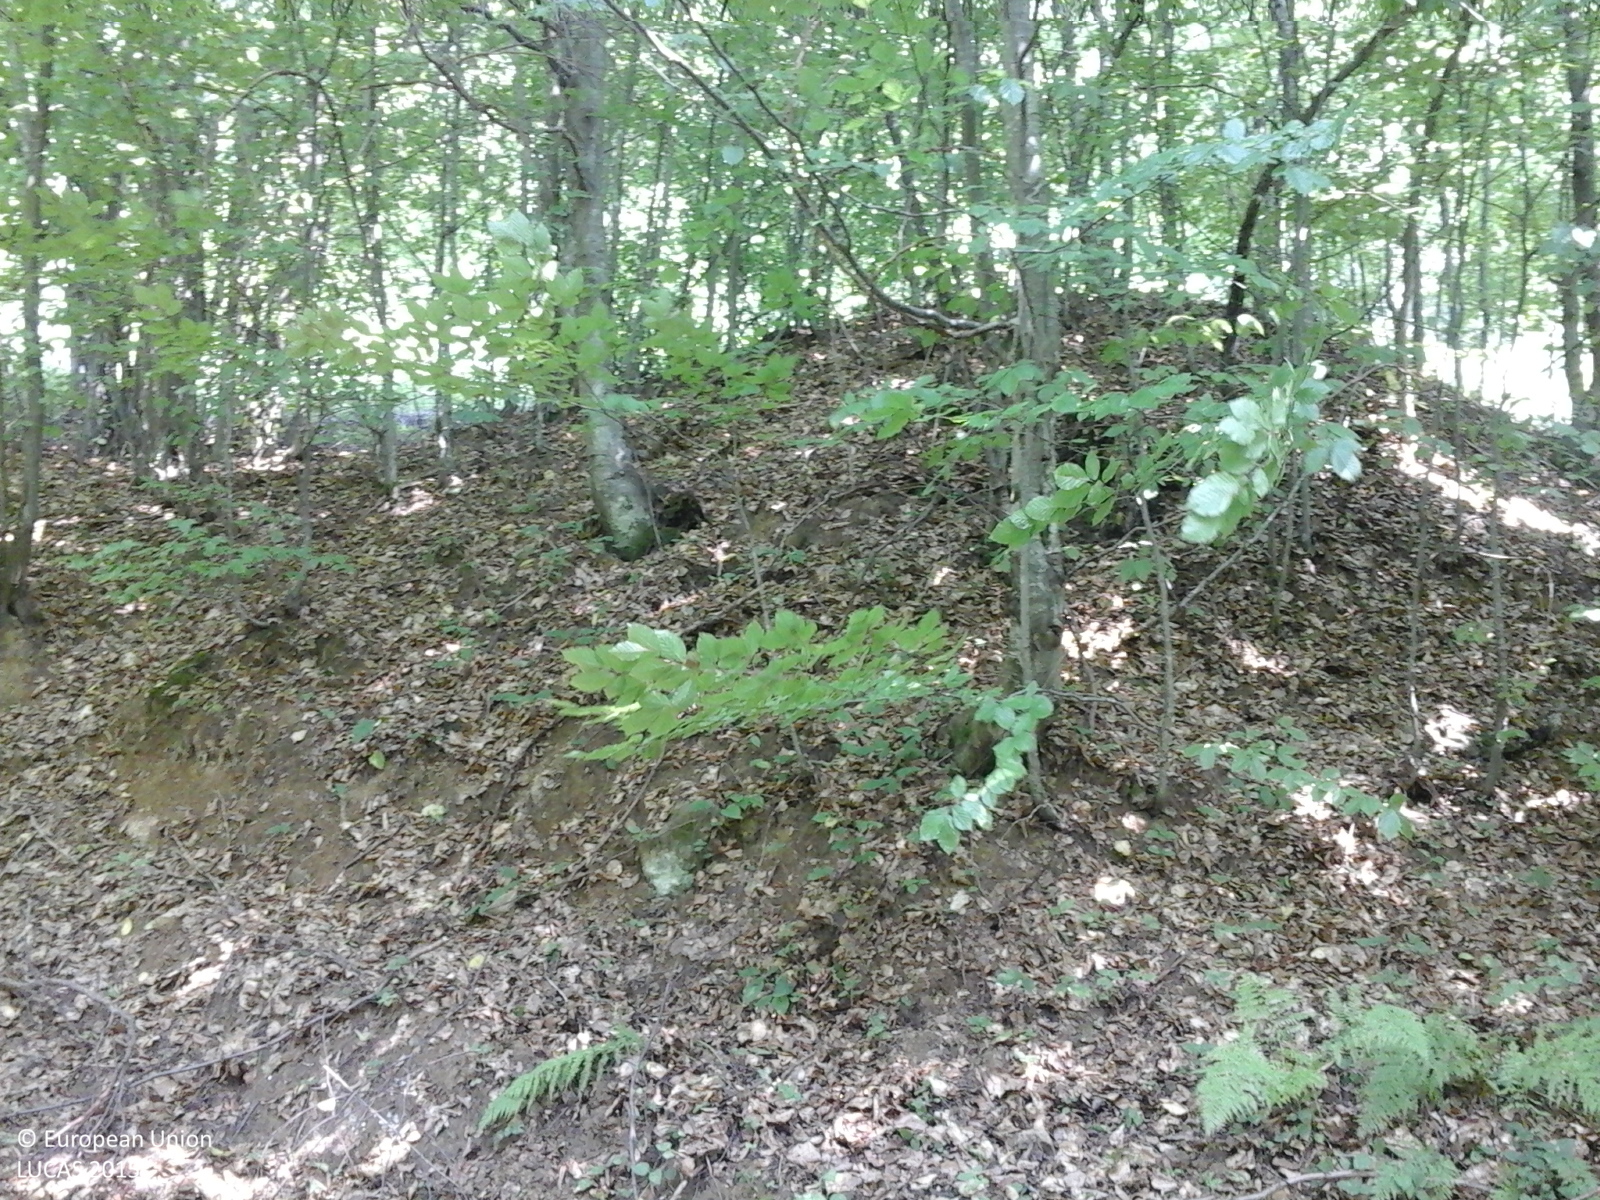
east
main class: Woodland
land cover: Broadleaved woodland
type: beech forest
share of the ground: > 75 %
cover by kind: broadleaved forest trees 100 %
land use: Forestry
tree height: > 5 m
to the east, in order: Broadleaved woodland; Rivers and streams; Broadleaved woodland; Tracks; Broadleaved woodland; Tracks; Broadleaved woodland
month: August
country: RO
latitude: 46.2387
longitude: 22.4600
